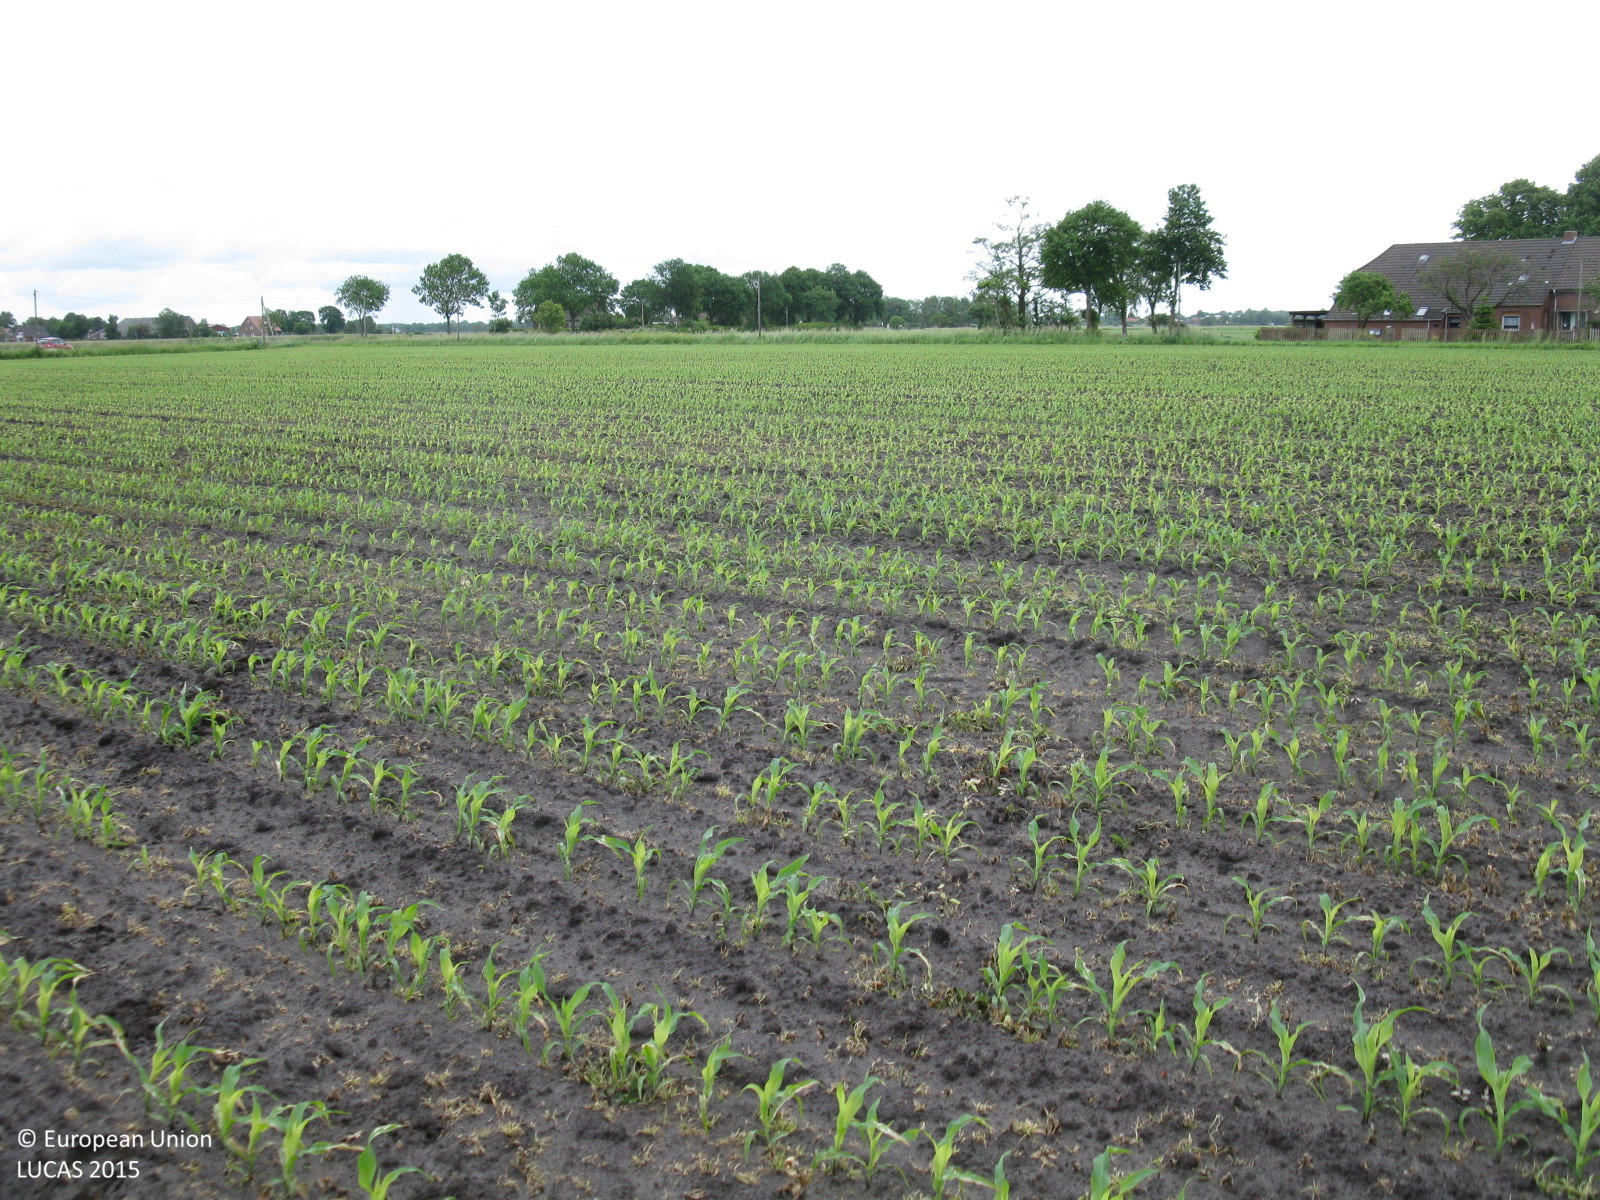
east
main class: Cropland
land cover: Maize
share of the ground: 10 - 25 %
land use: Agriculture (excluding fallow land and kitchen gardens)
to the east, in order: Maize; Electric lines; Grass margins; Paved roads, cycling and walking lanes; Grassland without tree/shrub cover; Ditches and canals; Maize; Ditches and canals; Maize
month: June
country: DE
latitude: 53.4452
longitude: 7.3658
